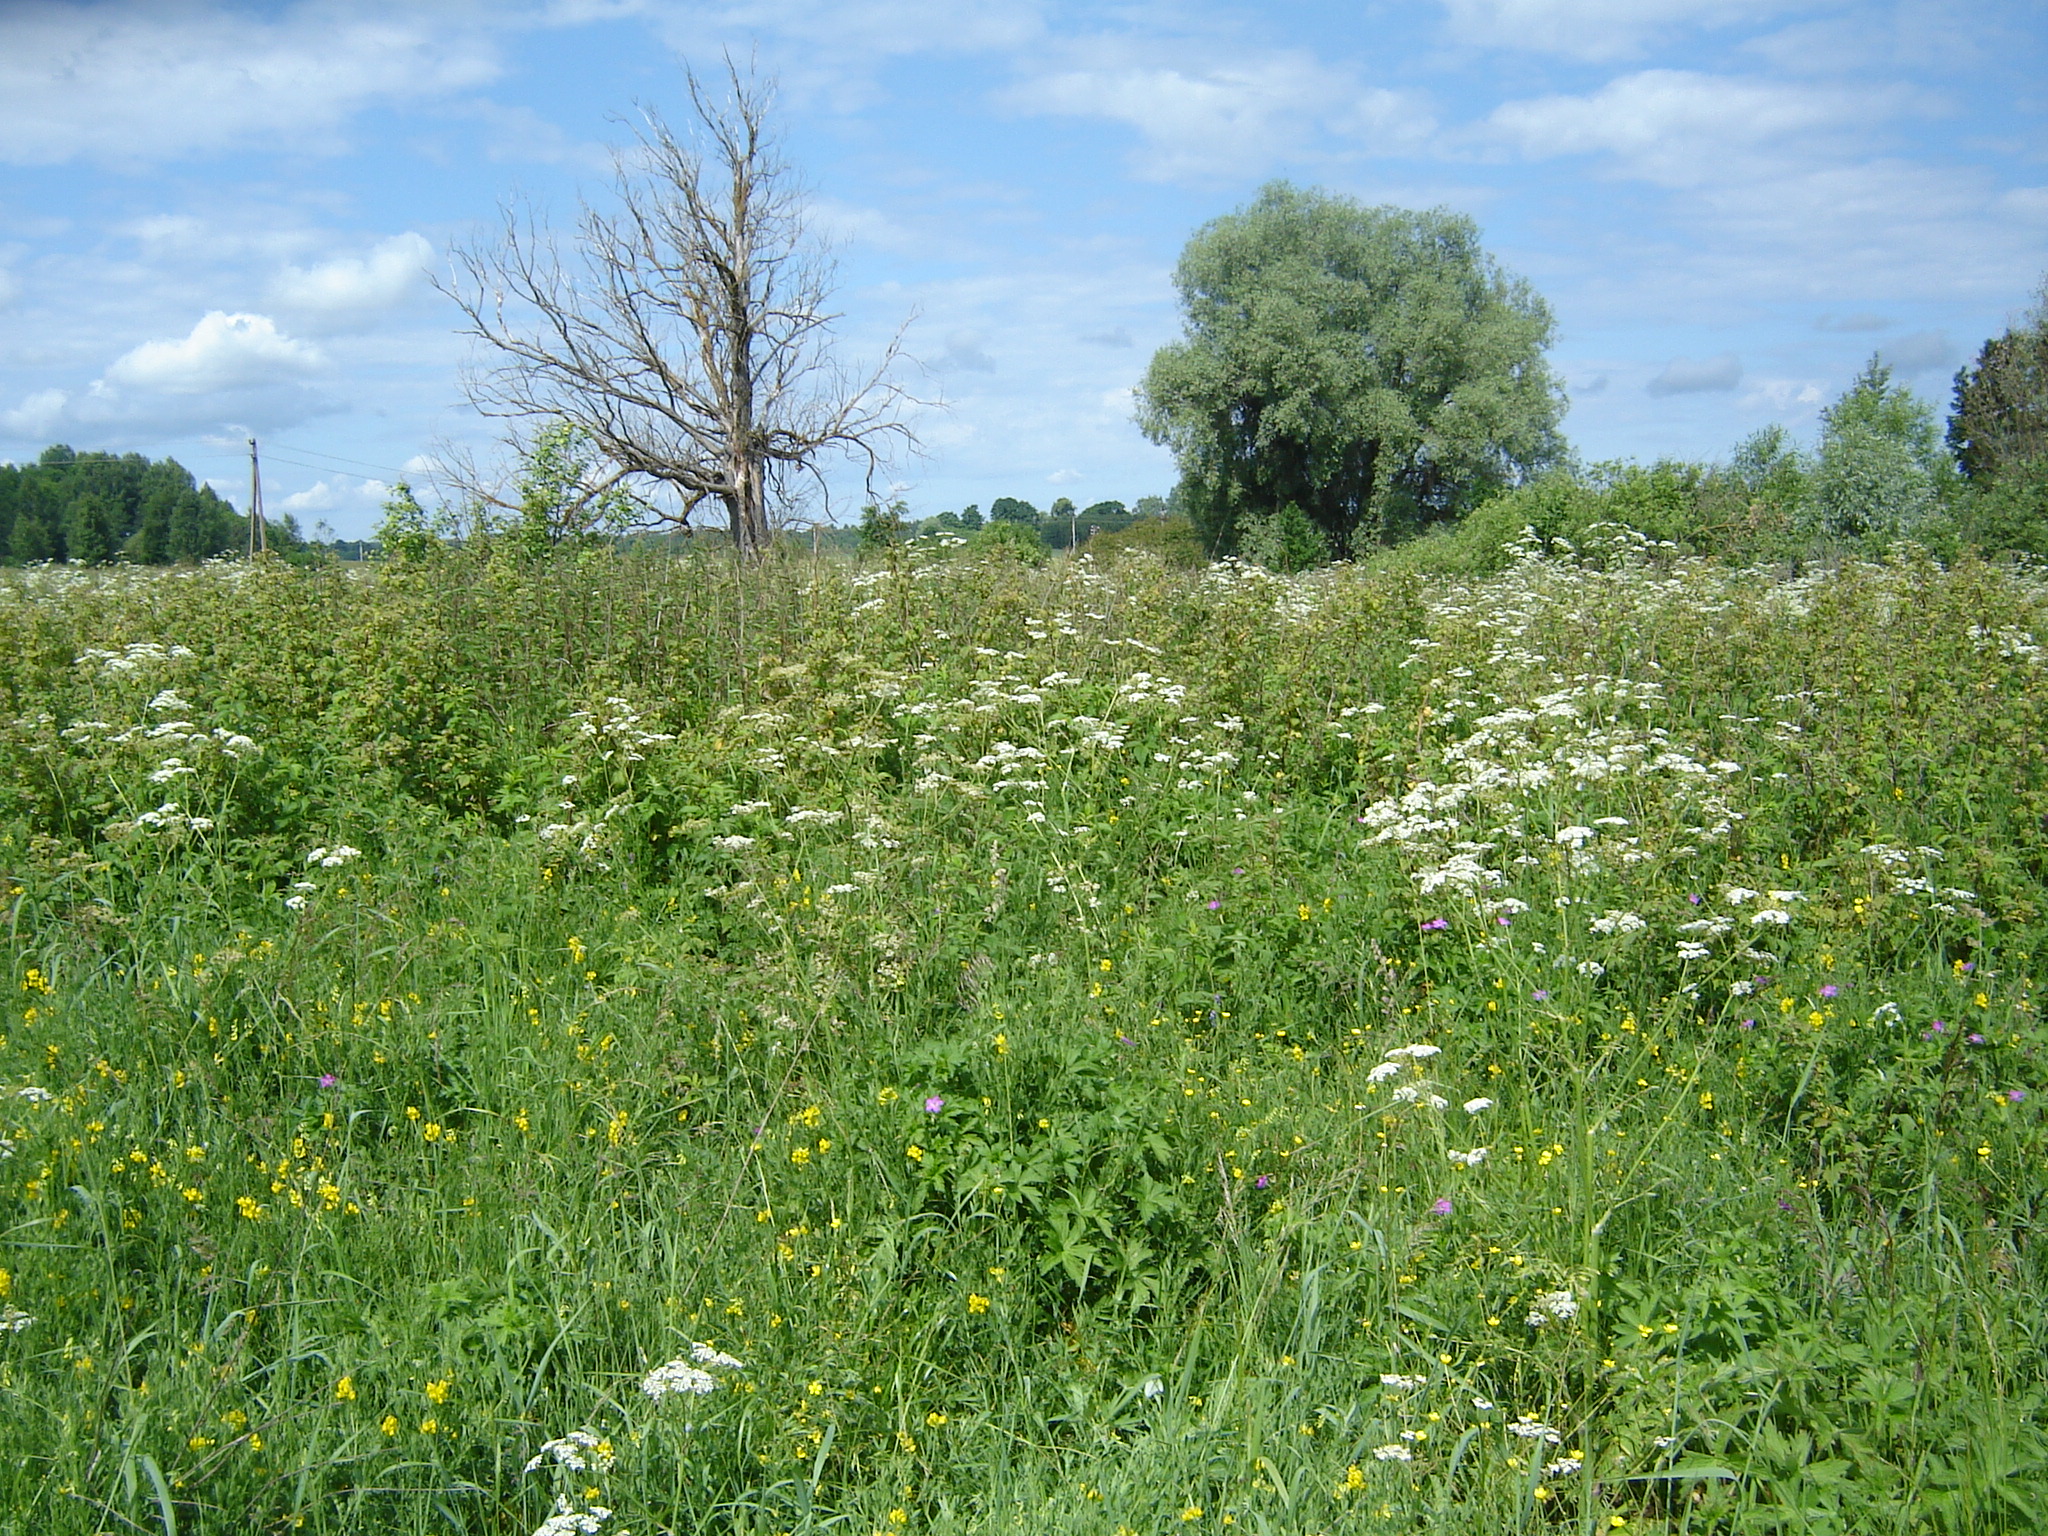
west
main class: Grassland
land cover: Spontaneously vegetated surfaces
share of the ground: > 75 %
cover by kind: herbaceous plants 100 %
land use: Fallow land
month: June
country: LT
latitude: 55.2247
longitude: 26.4546
